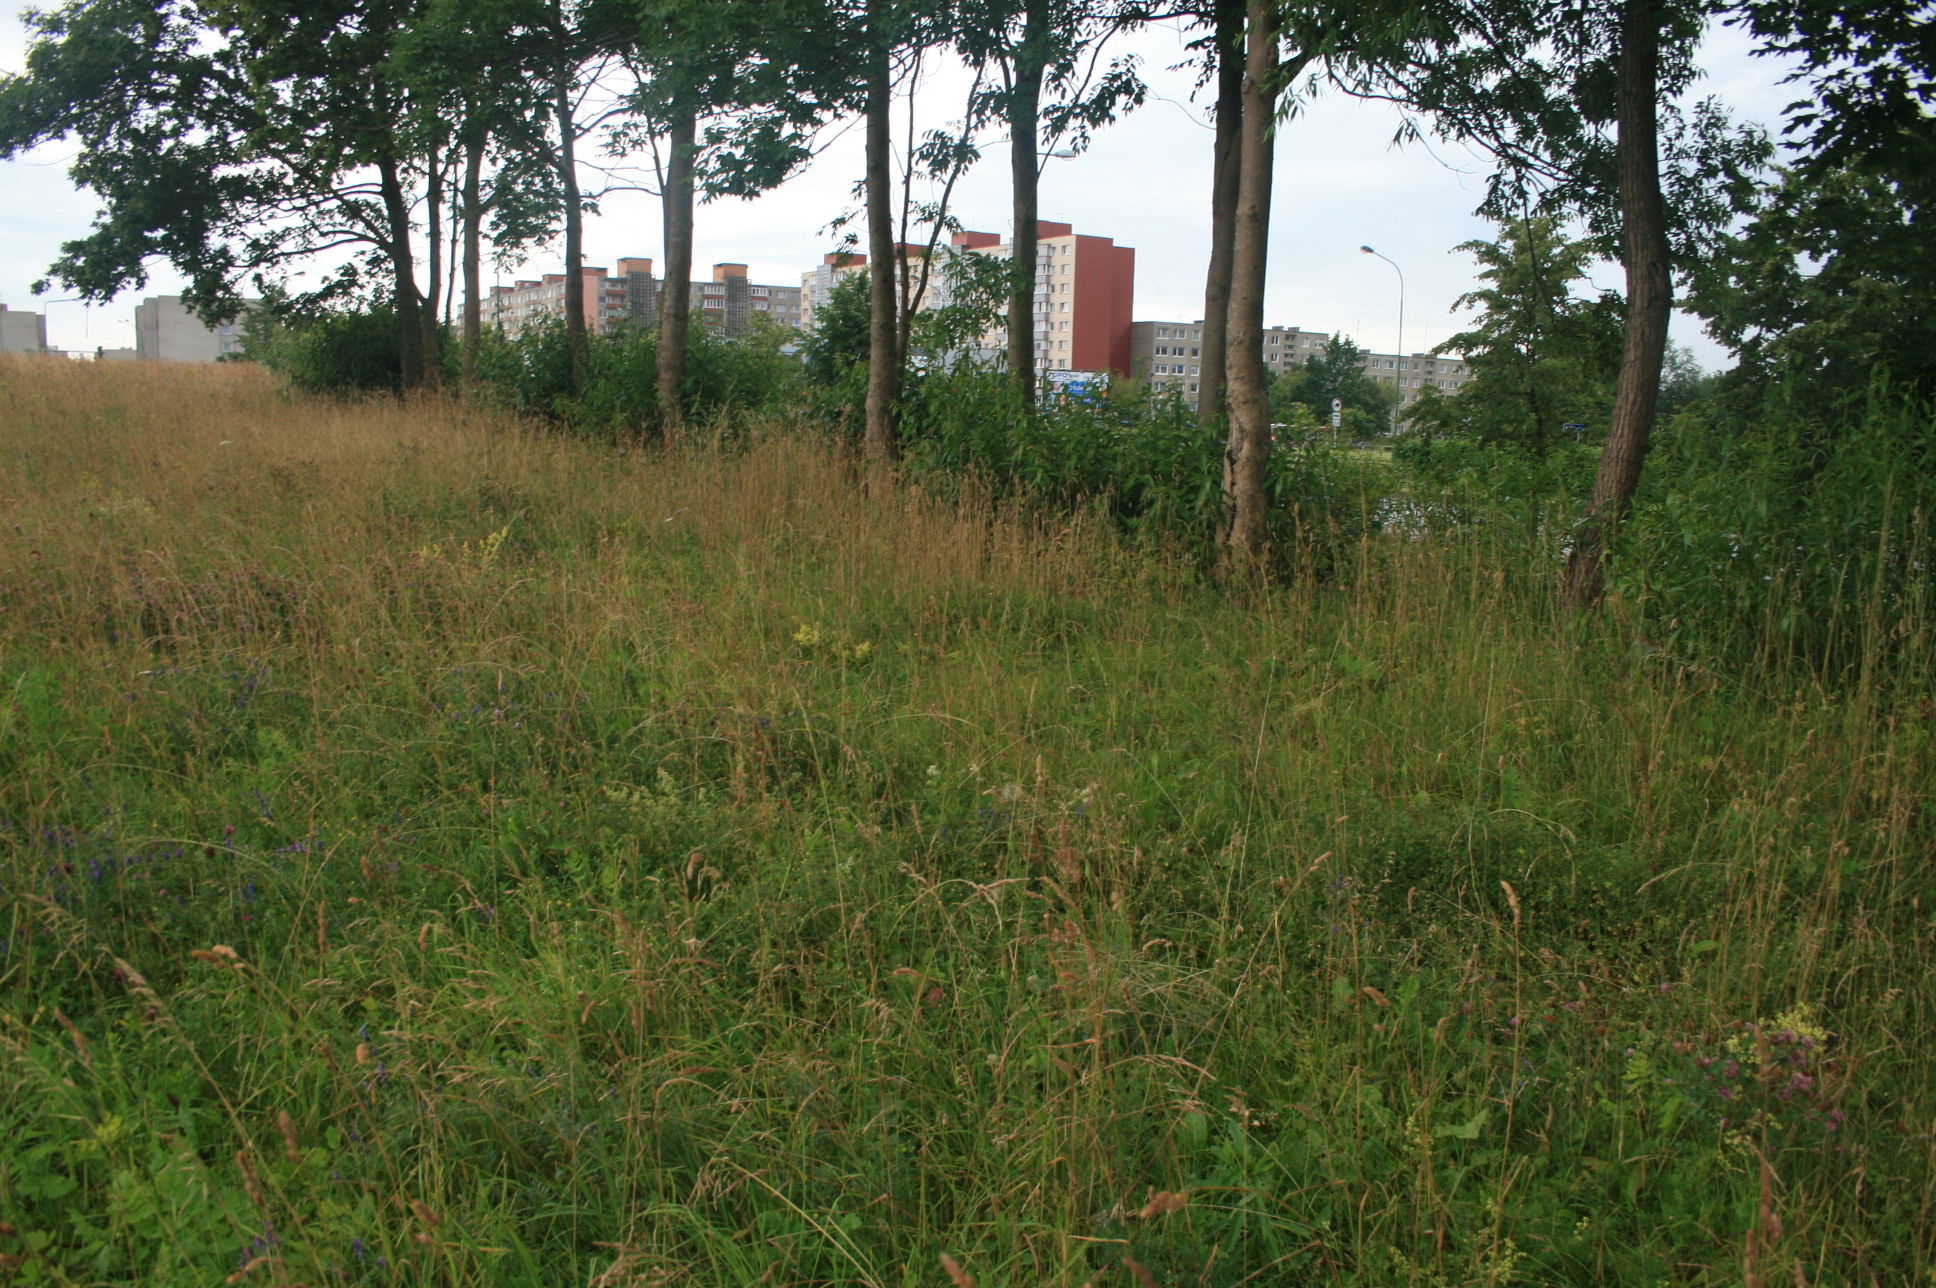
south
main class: Grassland
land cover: Grassland without tree/shrub cover
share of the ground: > 75 %
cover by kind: herbaceous plants 100 %
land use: Residential
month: July
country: LT
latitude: 55.6786
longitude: 21.1889
